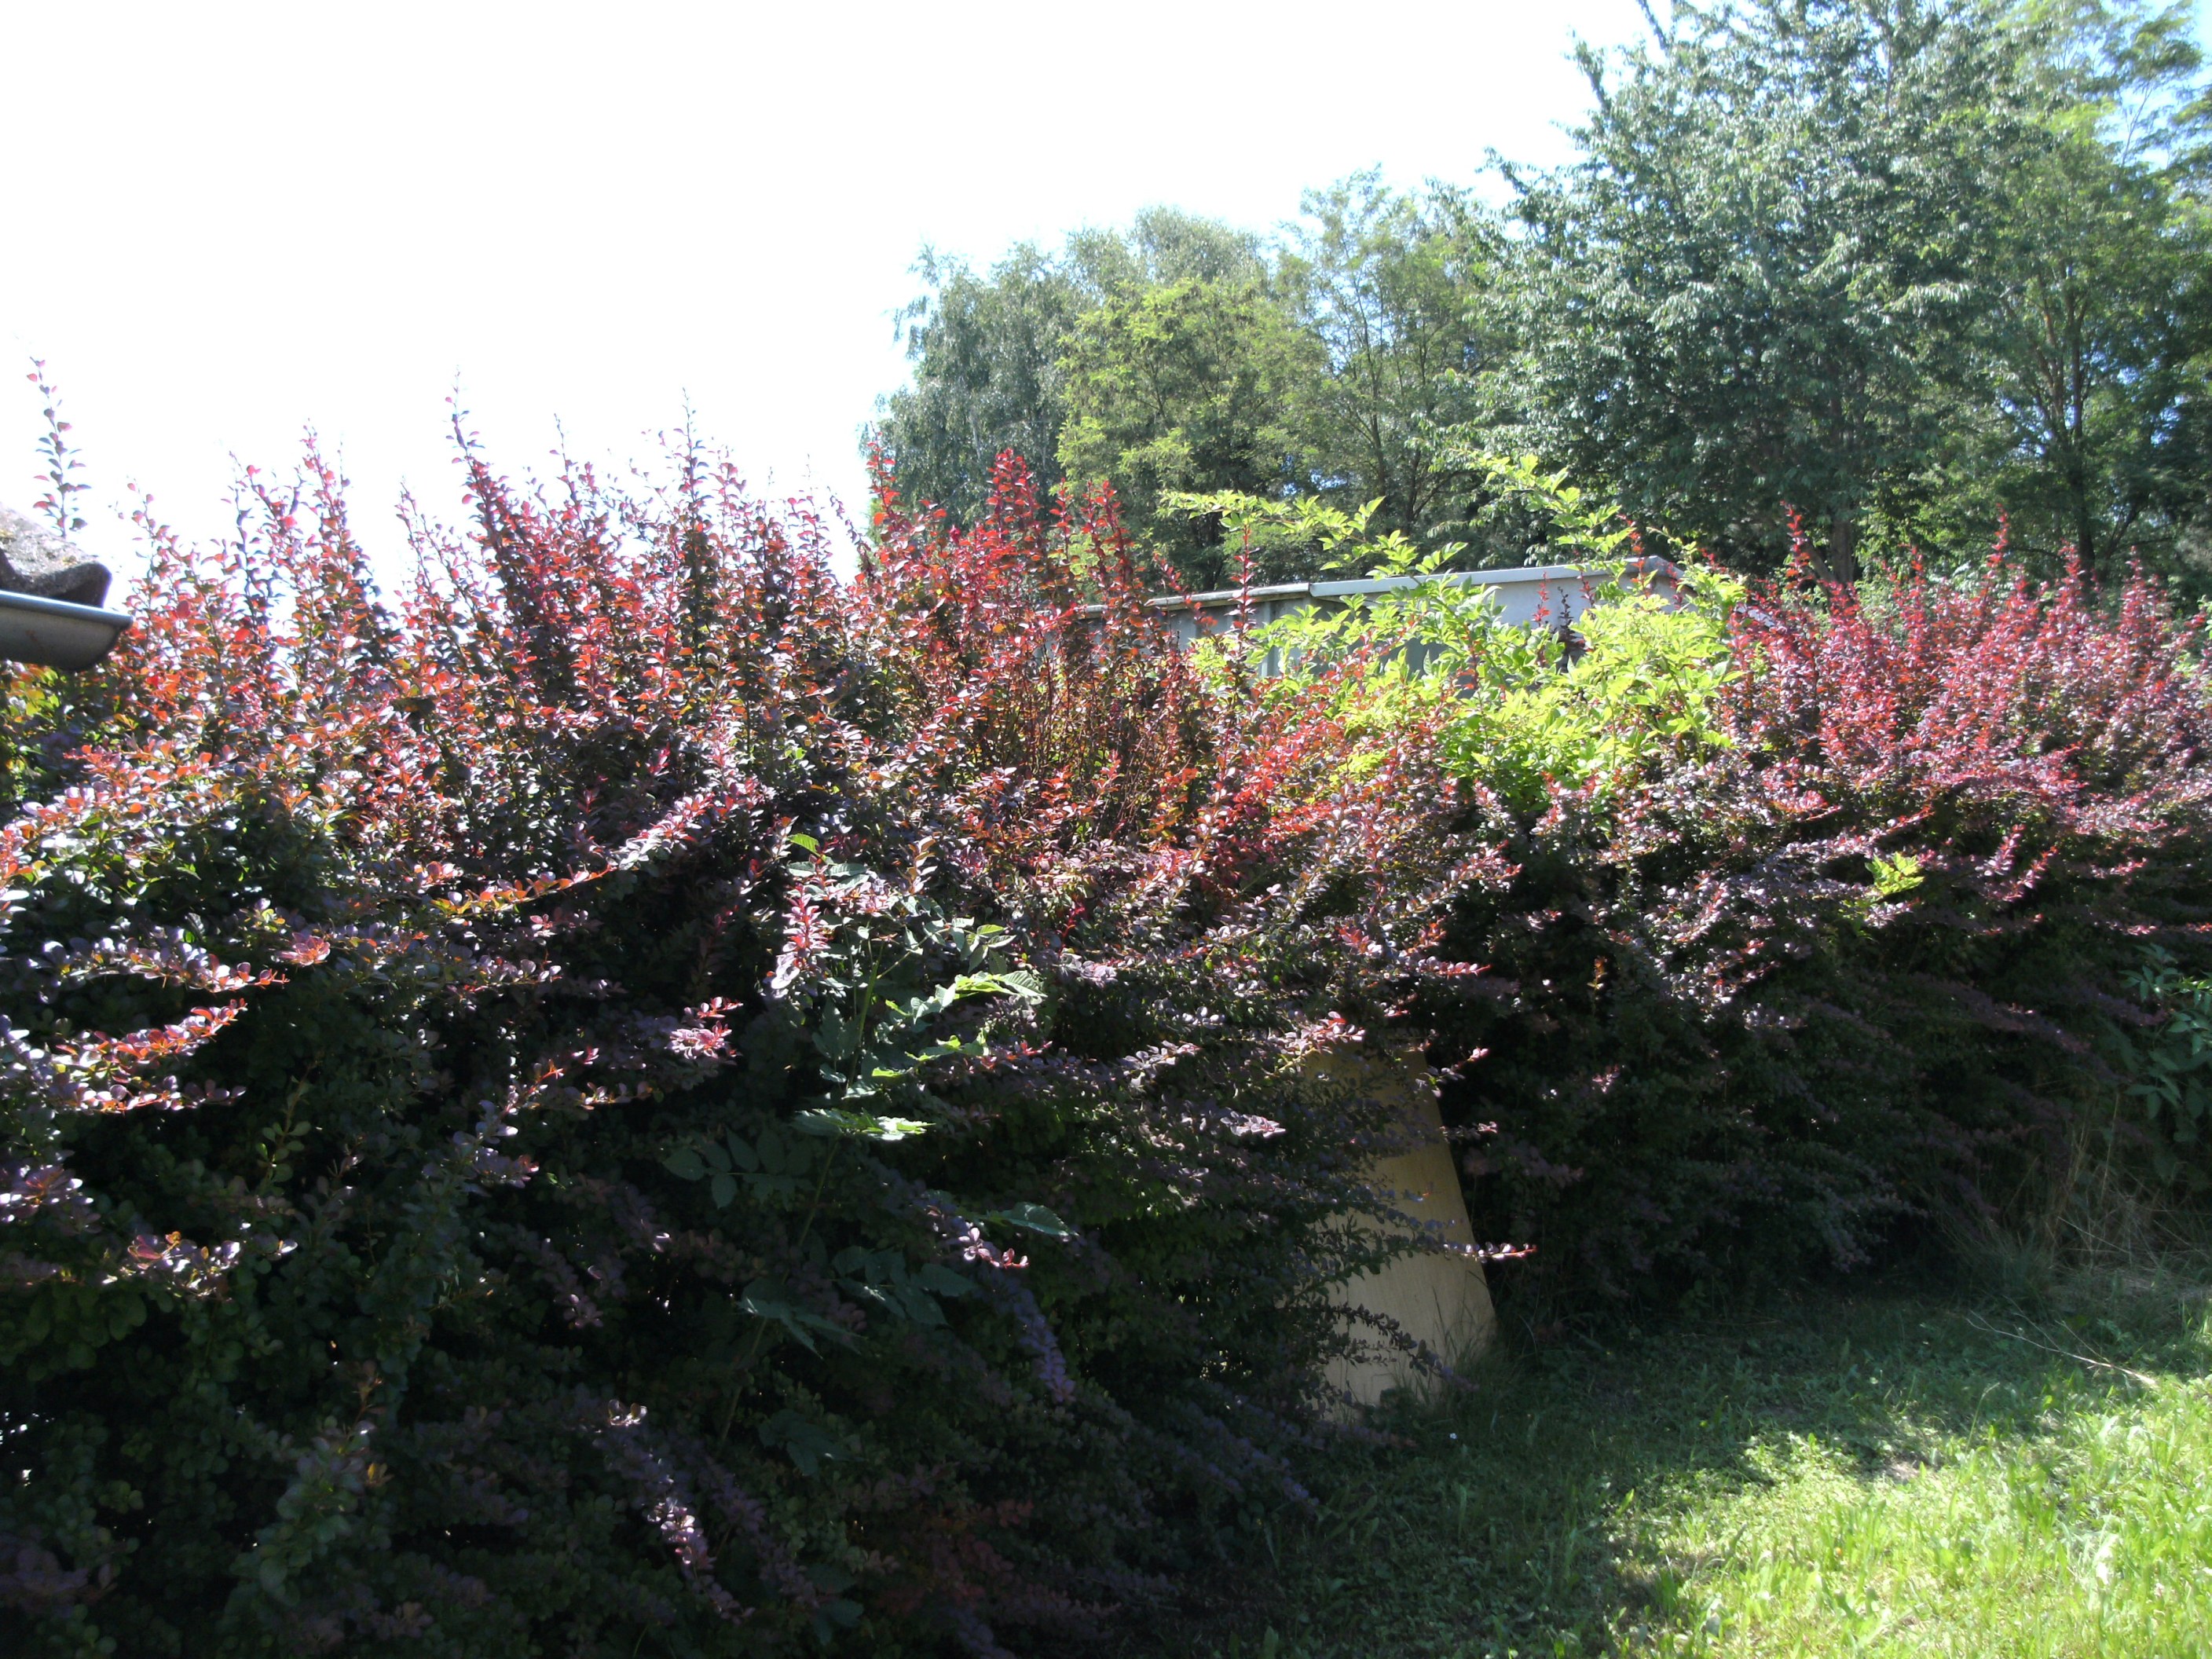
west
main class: Grassland
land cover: Grassland with sparse tree/shrub cover
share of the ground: > 75 %
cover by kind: herbaceous plants 95 %, broadleaved forest trees 5 %
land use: Residential
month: June
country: AT
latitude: 48.2118
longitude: 13.8080
